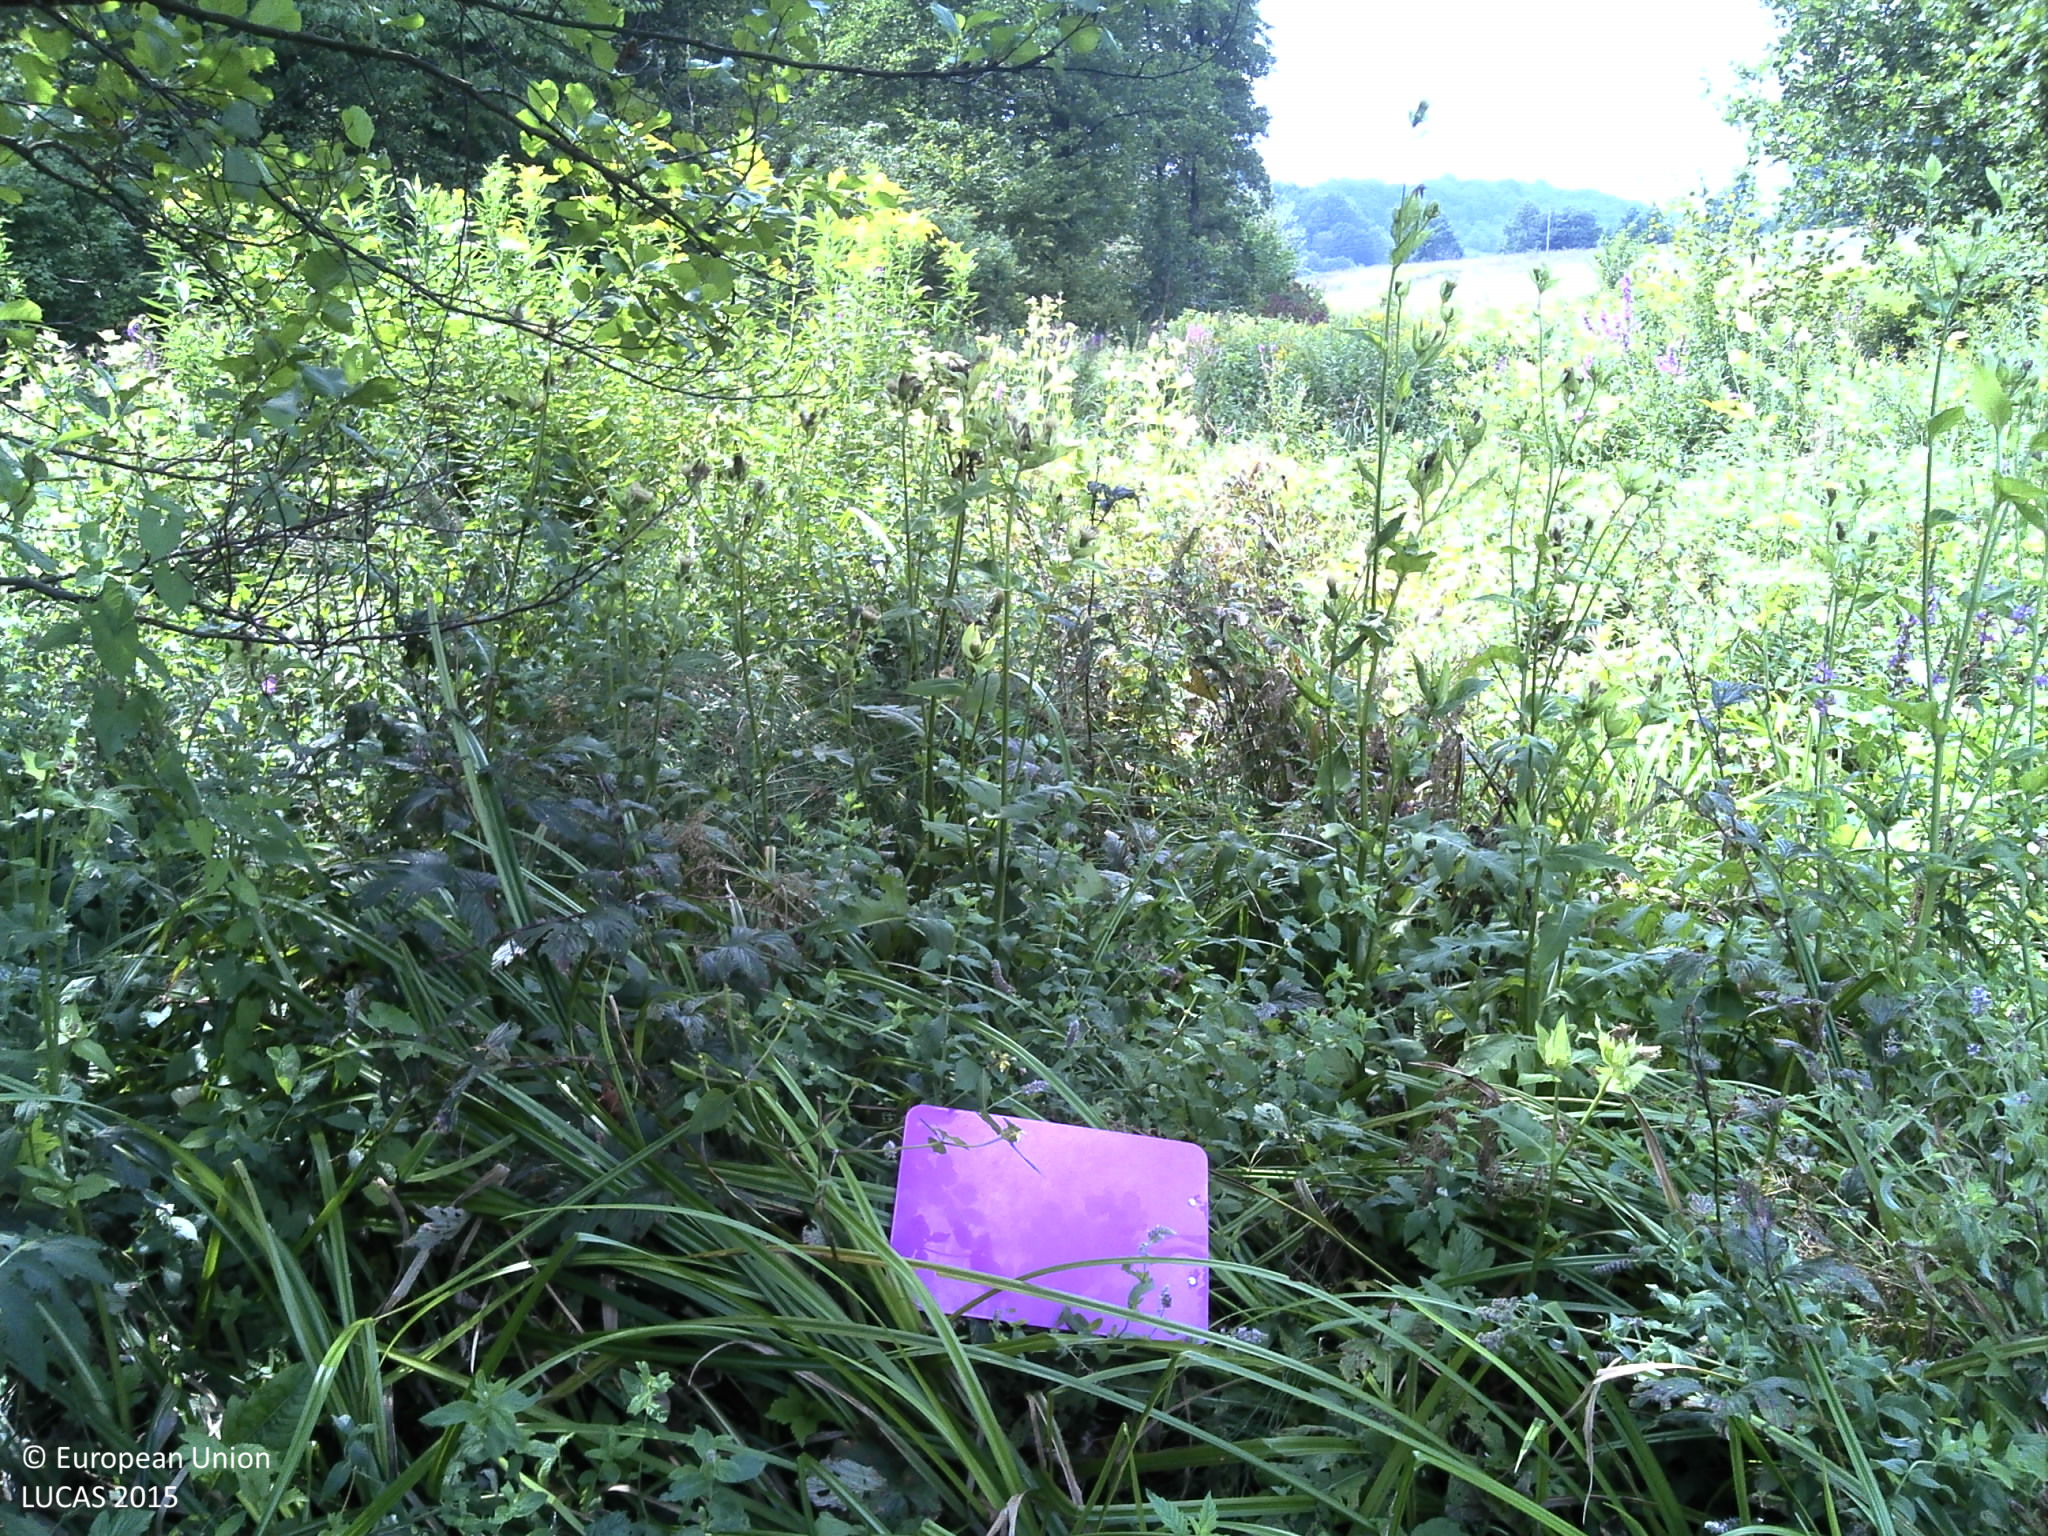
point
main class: Grassland
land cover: Spontaneously vegetated surfaces
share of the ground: > 75 %
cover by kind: herbaceous plants 100 %
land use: Fallow land
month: August
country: HR
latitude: 45.2931
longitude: 16.0788
